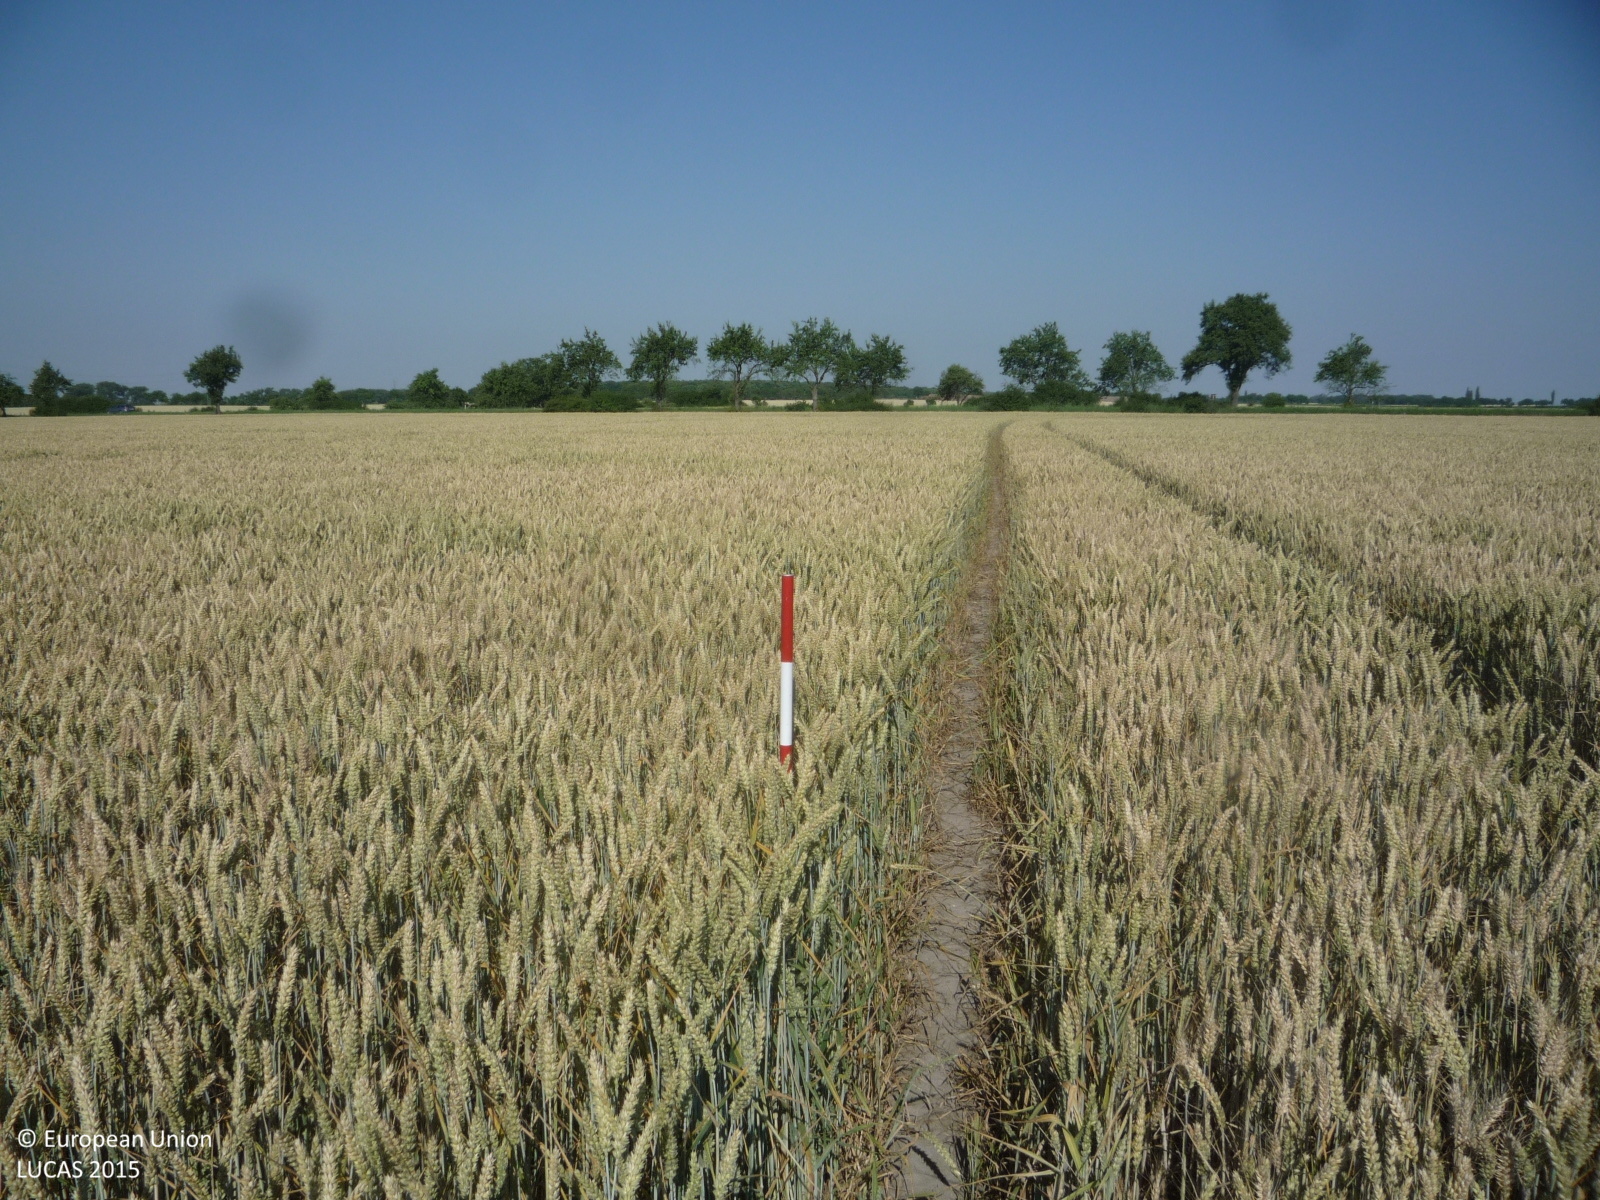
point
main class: Cropland
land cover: Common wheat
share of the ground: > 75 %
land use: Agriculture (excluding fallow land and kitchen gardens)
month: July
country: CZ
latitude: 50.1751
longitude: 15.1700
